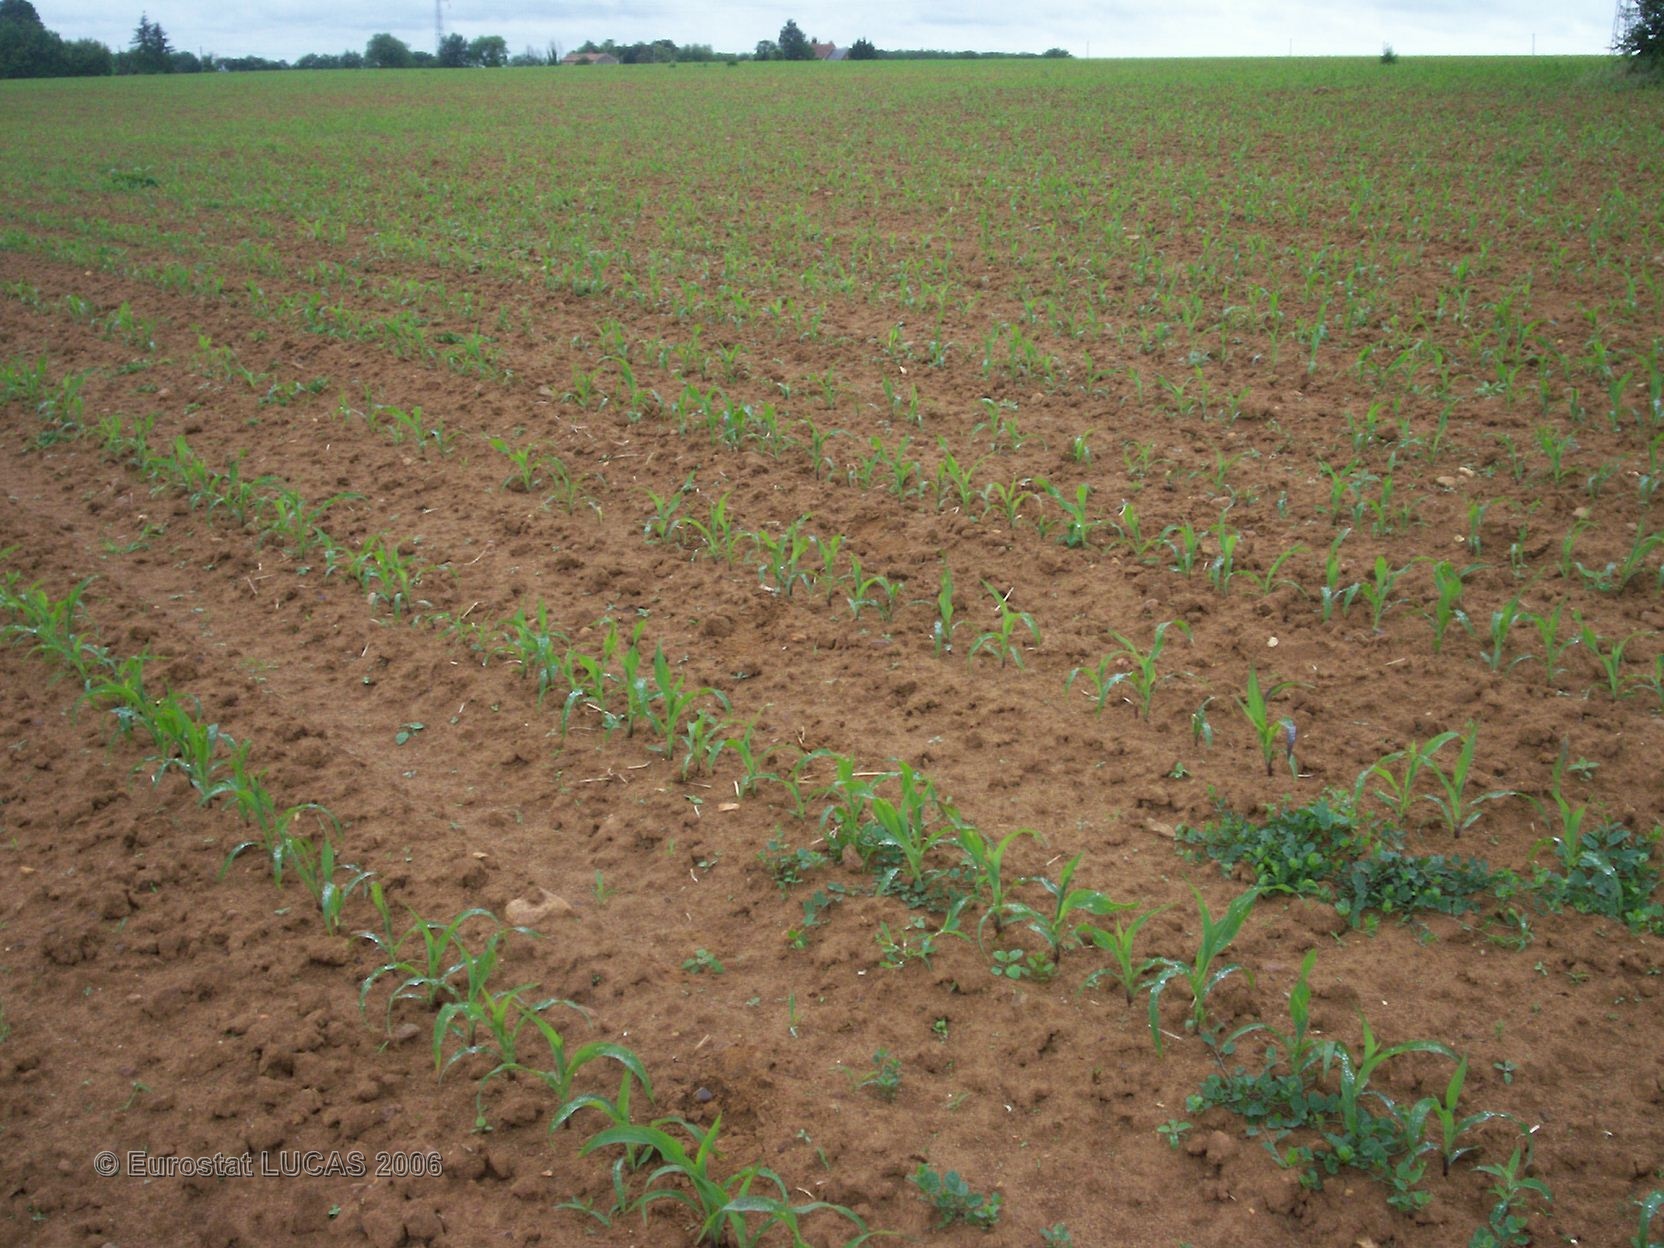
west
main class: Cropland
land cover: Maize
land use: Agriculture (excluding fallow land and kitchen gardens)
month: May
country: FR
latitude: 46.6845
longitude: 0.4501
